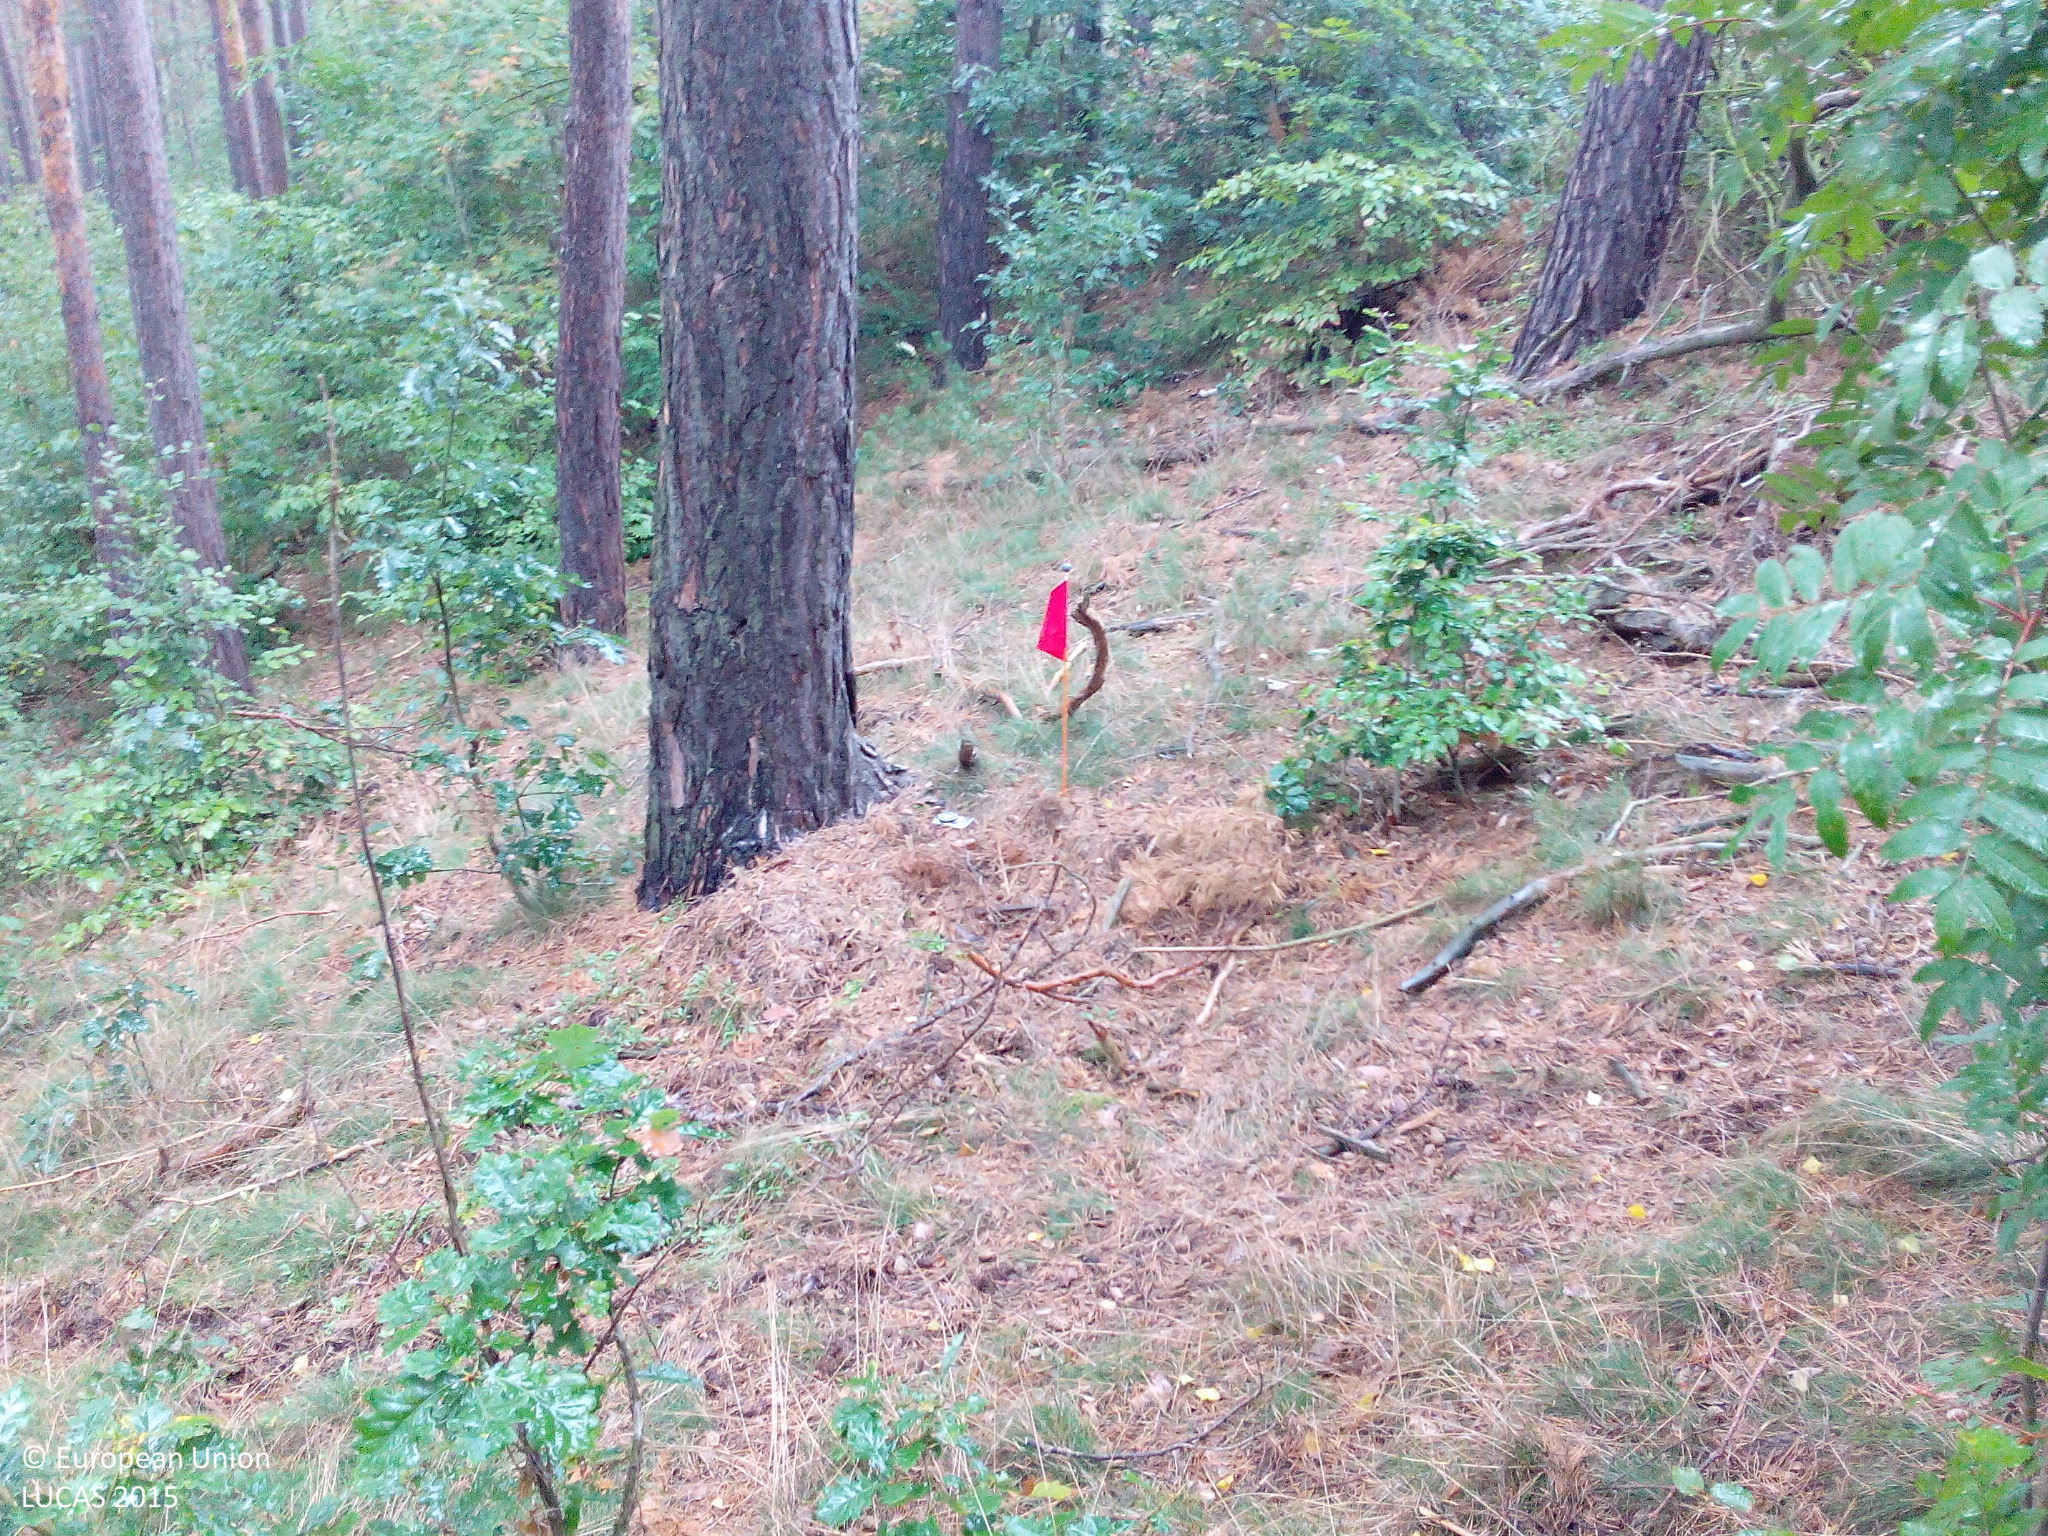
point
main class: Woodland
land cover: Pine dominated mixed woodland
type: hemiboreal forest and nemoral coniferous forest and mixed broadleaved-coniferous forest
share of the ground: > 75 %
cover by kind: coniferous forest trees 75 %, broadleaved forest trees 25 %
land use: Forestry
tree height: > 5 m
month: September
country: DE
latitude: 51.4203
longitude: 11.0207
